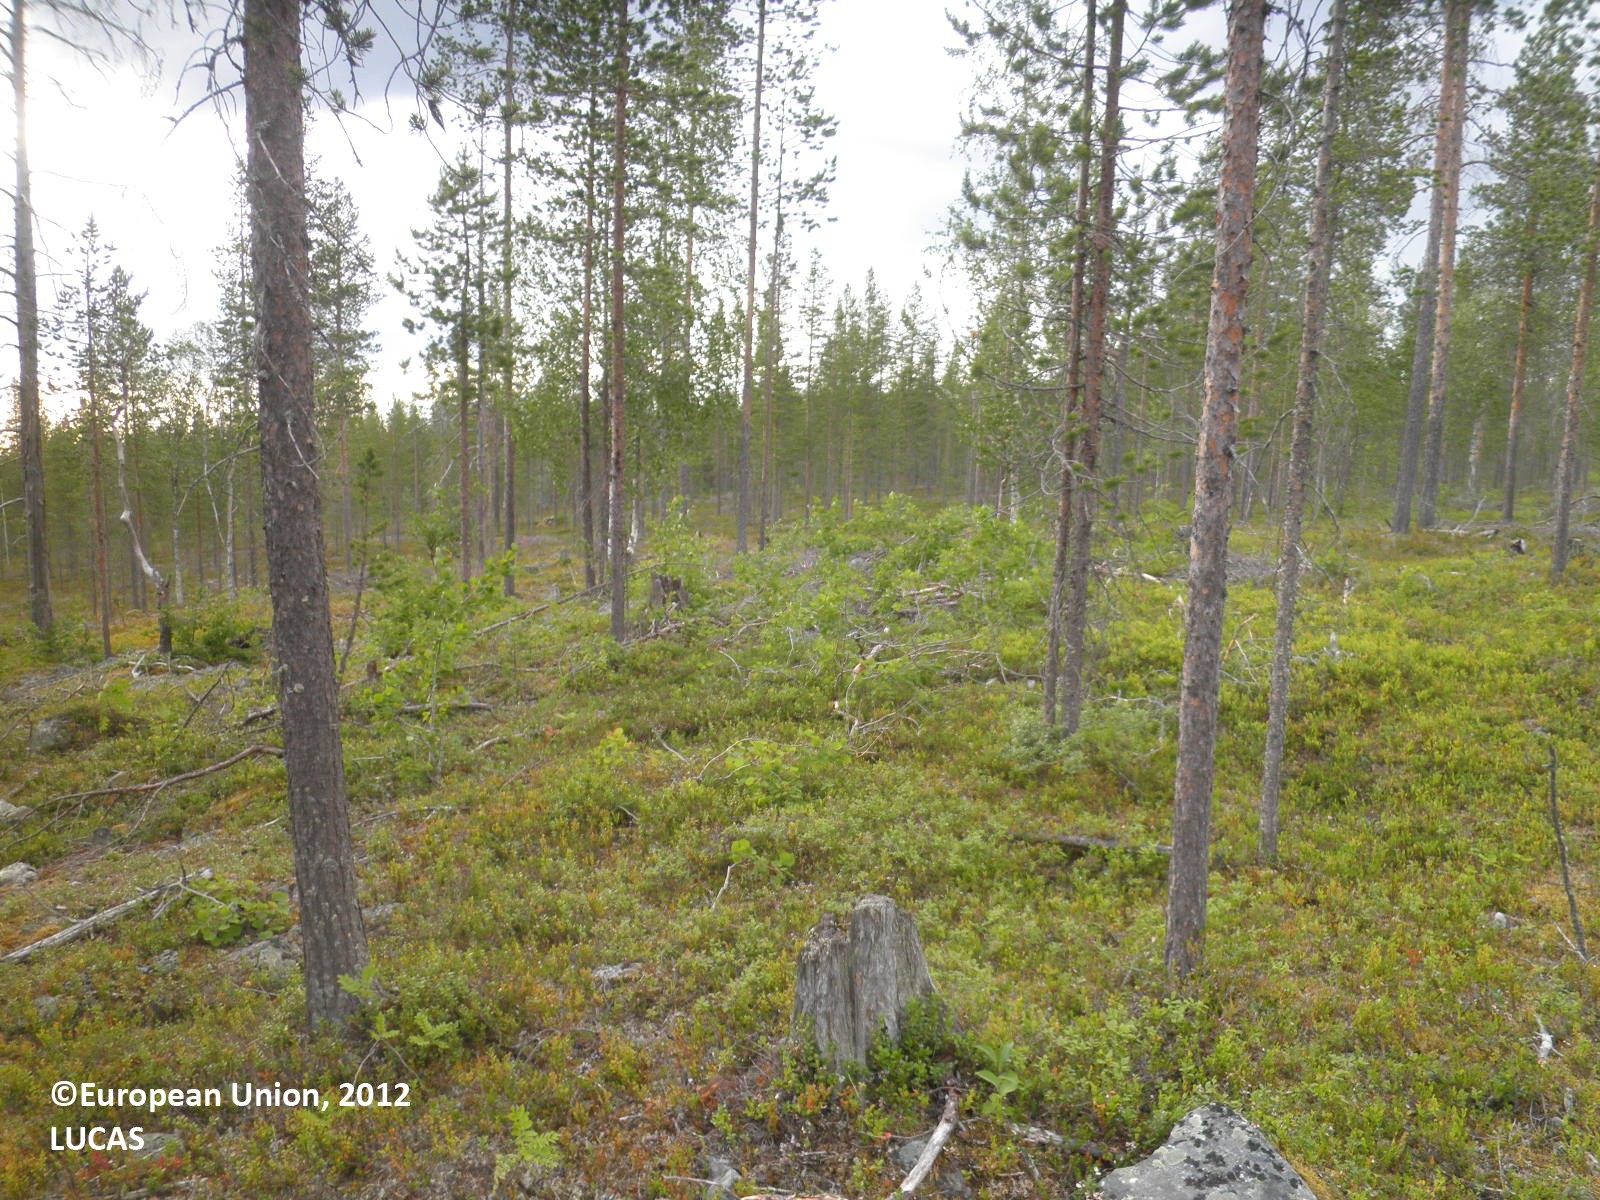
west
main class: Woodland
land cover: Pine dominated coniferous woodland
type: boreal forest
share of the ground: 25 - 50 %
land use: Forestry
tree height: > 5 m
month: July
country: FI
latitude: 67.5282
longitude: 26.0254
